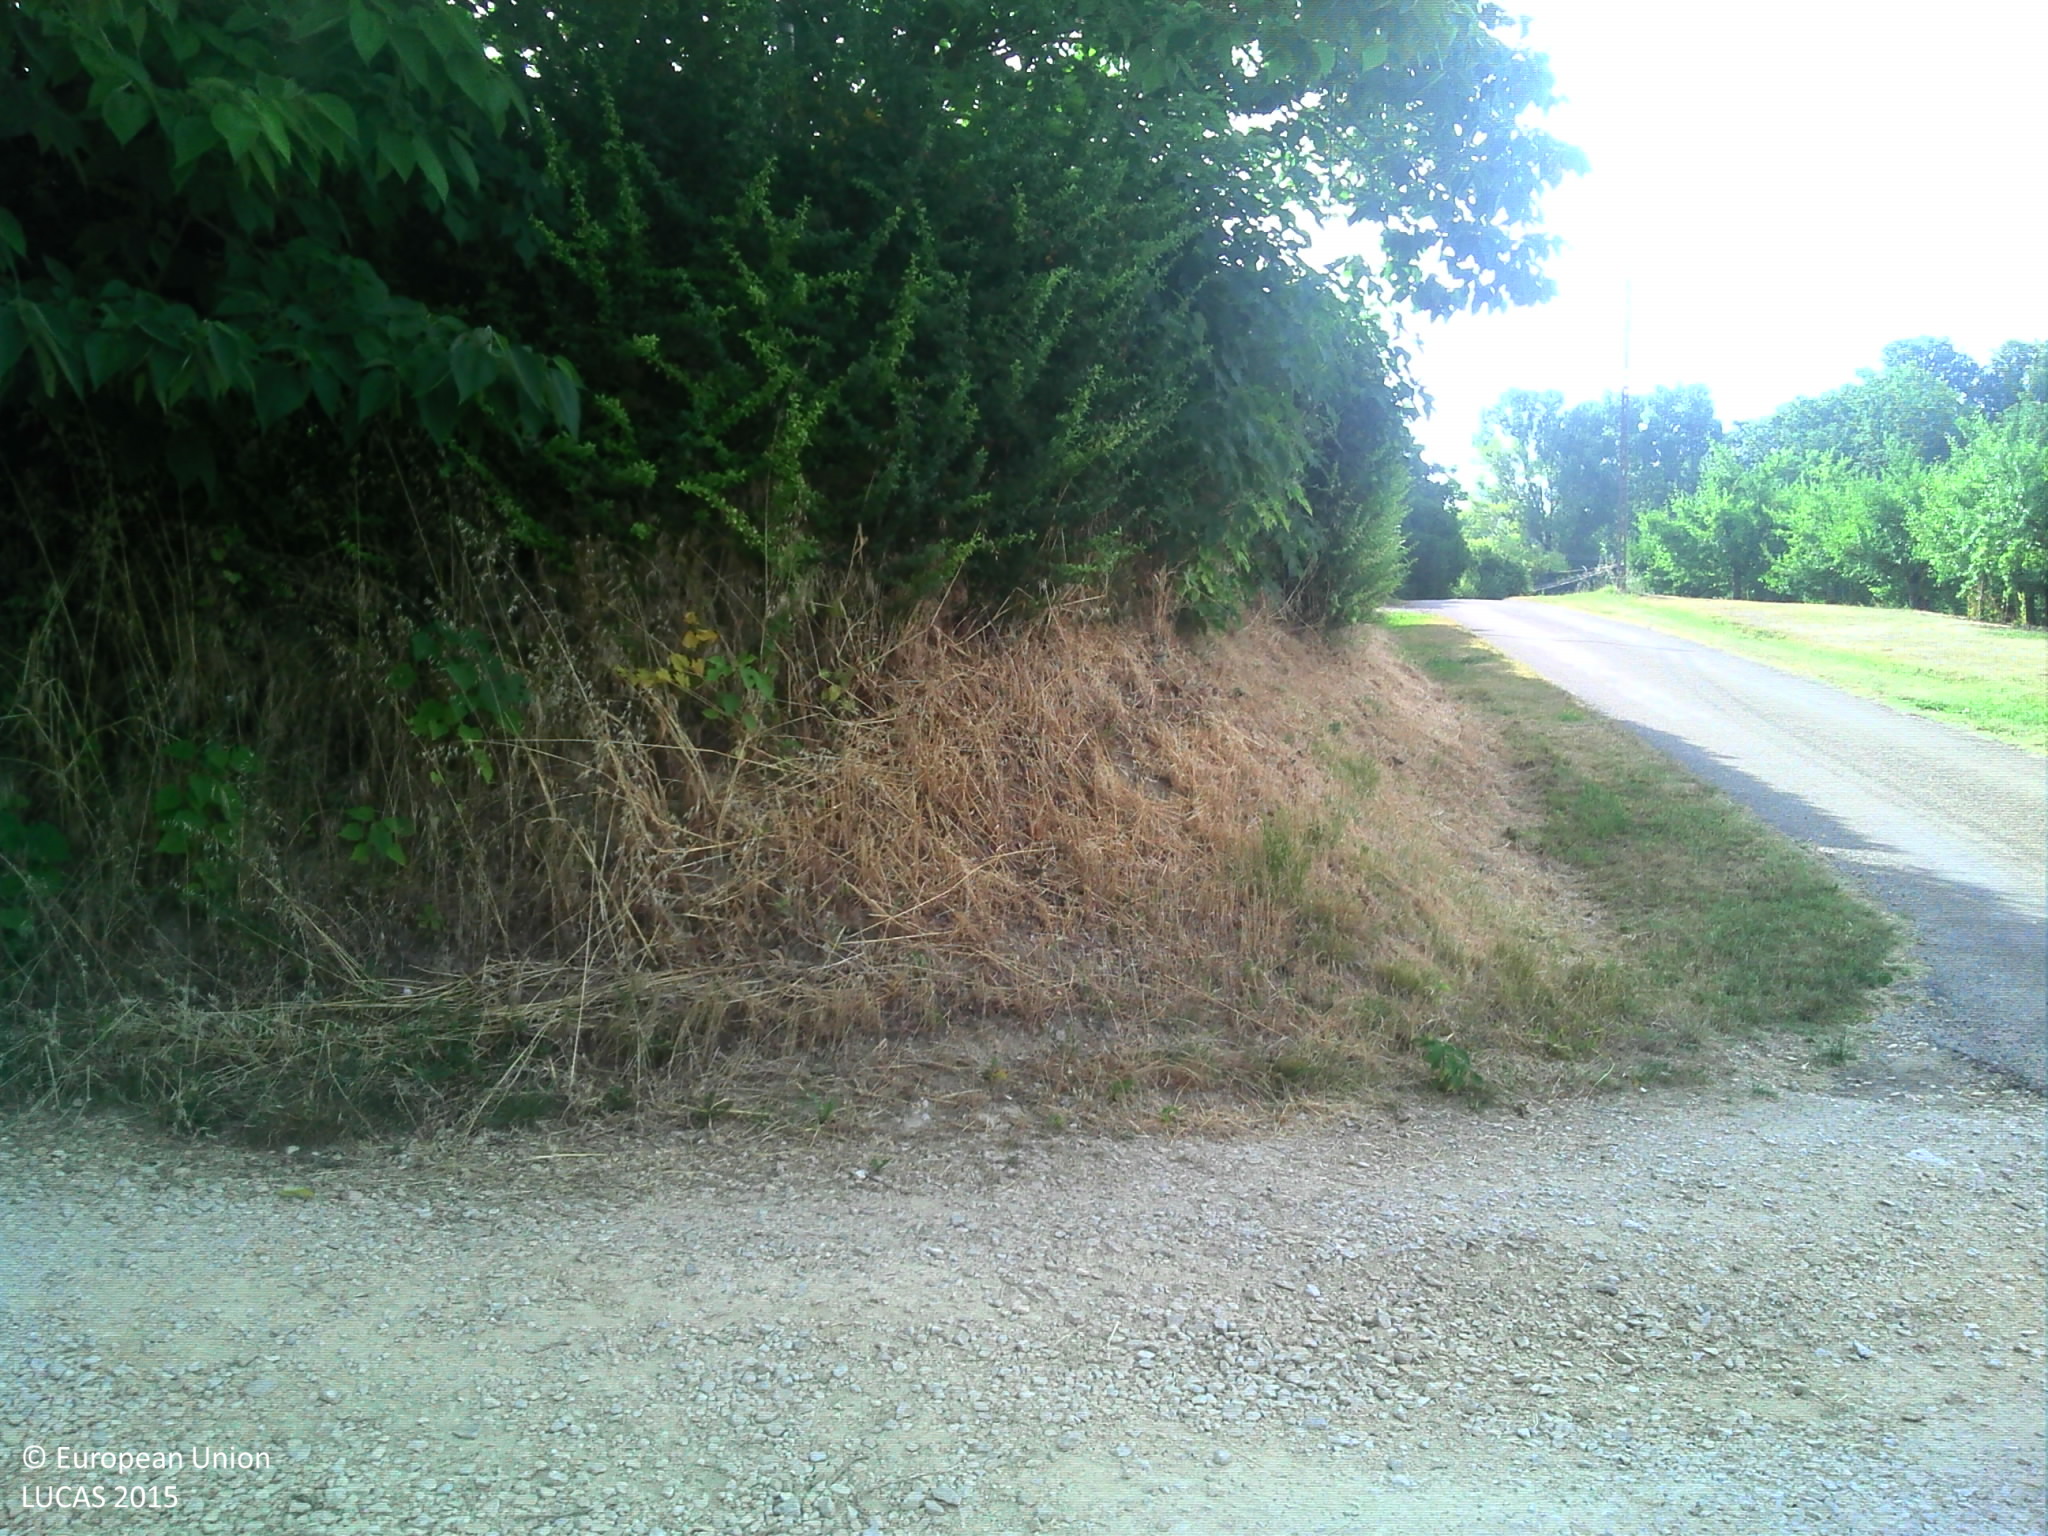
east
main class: Grassland
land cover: Grassland without tree/shrub cover
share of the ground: > 75 %
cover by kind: herbaceous plants 100 %
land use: Agriculture (excluding fallow land and kitchen gardens)
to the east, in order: Grassland without tree/shrub cover; Artificial constructions in urban areas; Lucerne; Barley; Electric lines; Ditches and canals; Grass margins; Paved roads, cycling and walking lanes; Ditches and canals; Grassland without tree/shrub cover
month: July
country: FR
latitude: 44.3692
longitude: 0.9228
